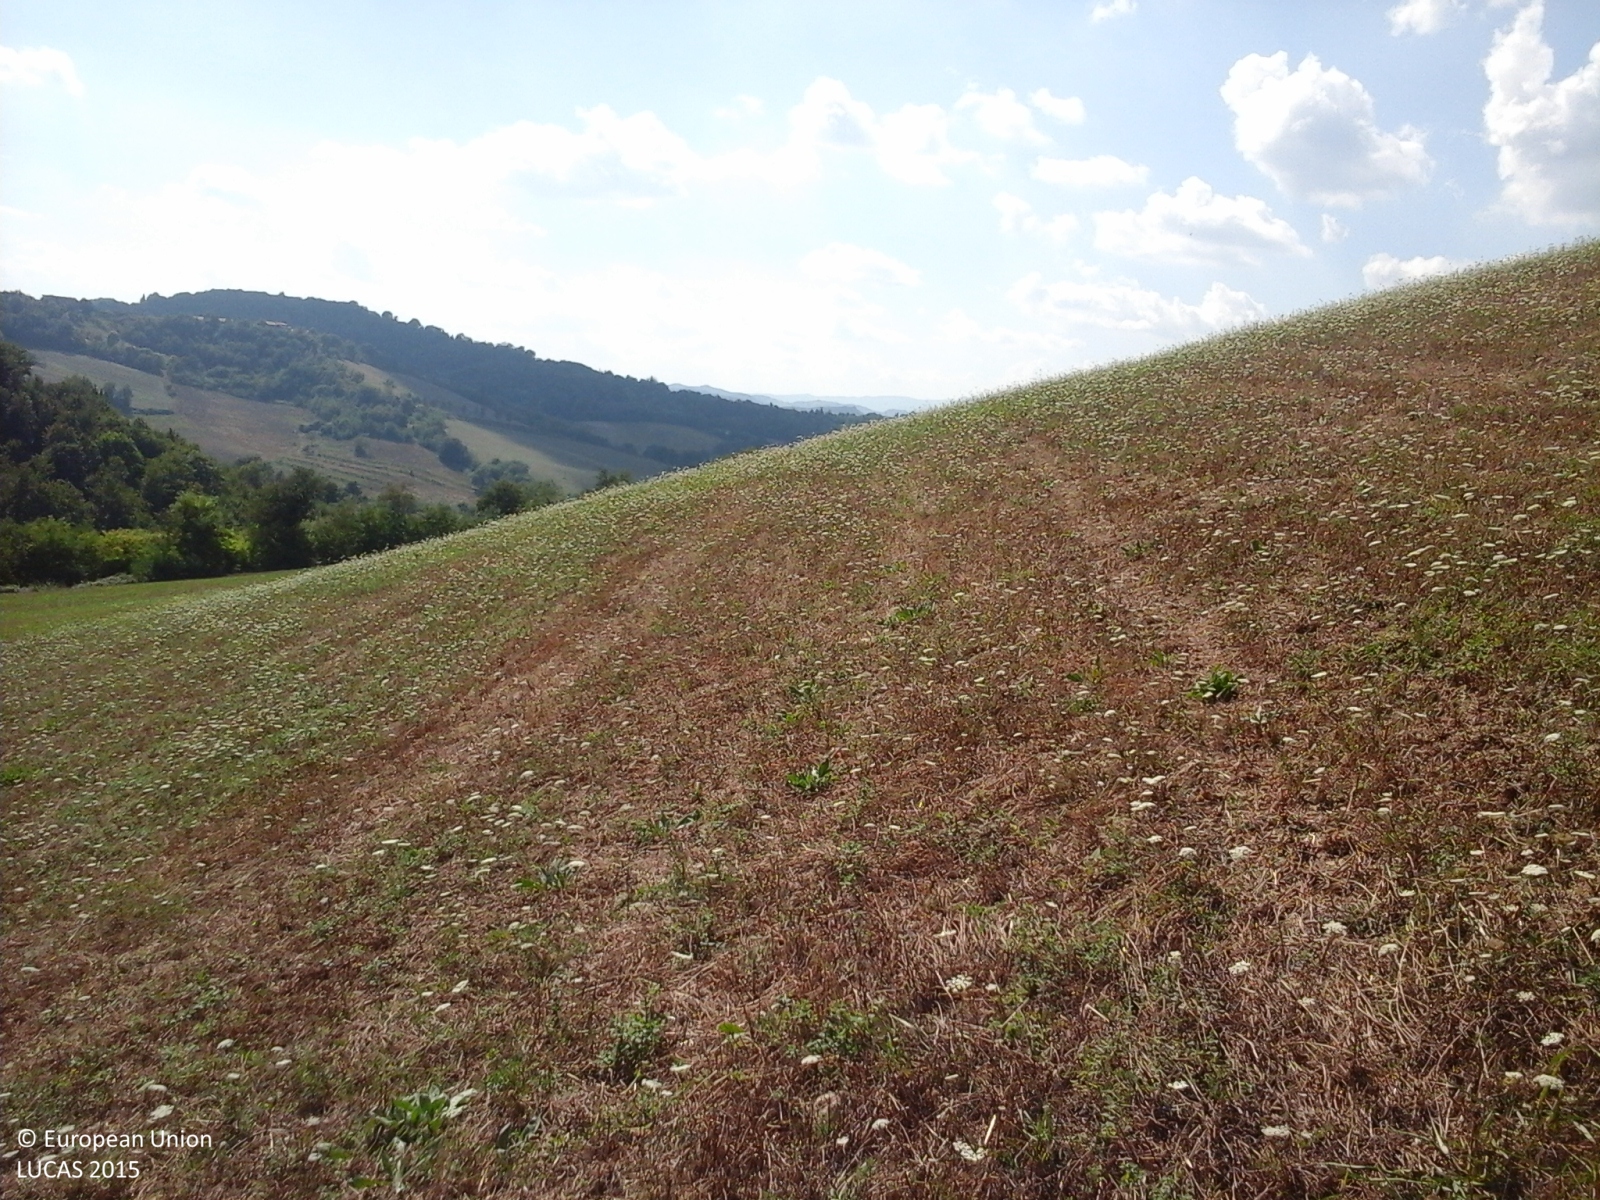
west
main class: Cropland
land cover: Other non-permanent industrial crops
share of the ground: 50 - 75 %
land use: Agriculture (excluding fallow land and kitchen gardens)
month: August
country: IT
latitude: 43.7575
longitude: 12.6391
